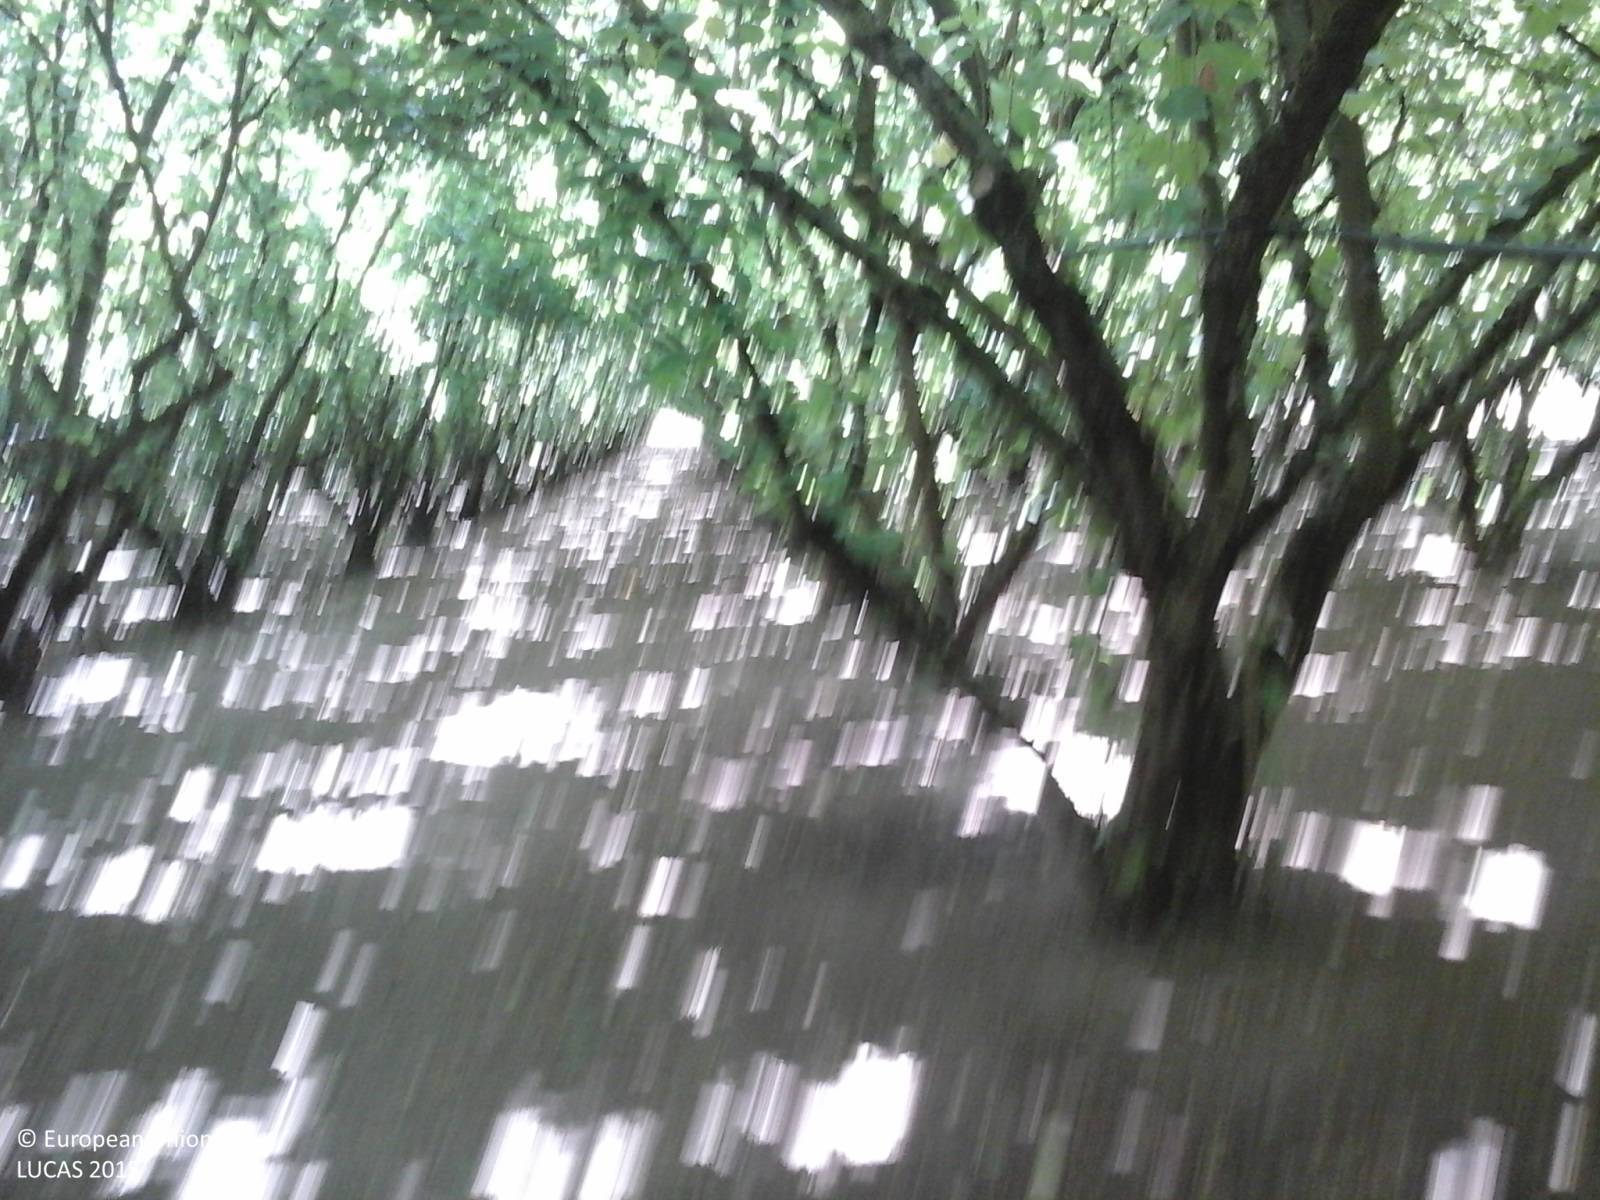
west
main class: Cropland
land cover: Nuts trees
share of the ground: > 75 %
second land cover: Other bare soil
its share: > 75 %
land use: Agriculture (excluding fallow land and kitchen gardens)
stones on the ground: < 10 %
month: July
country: IT
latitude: 42.2844
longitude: 12.3082
